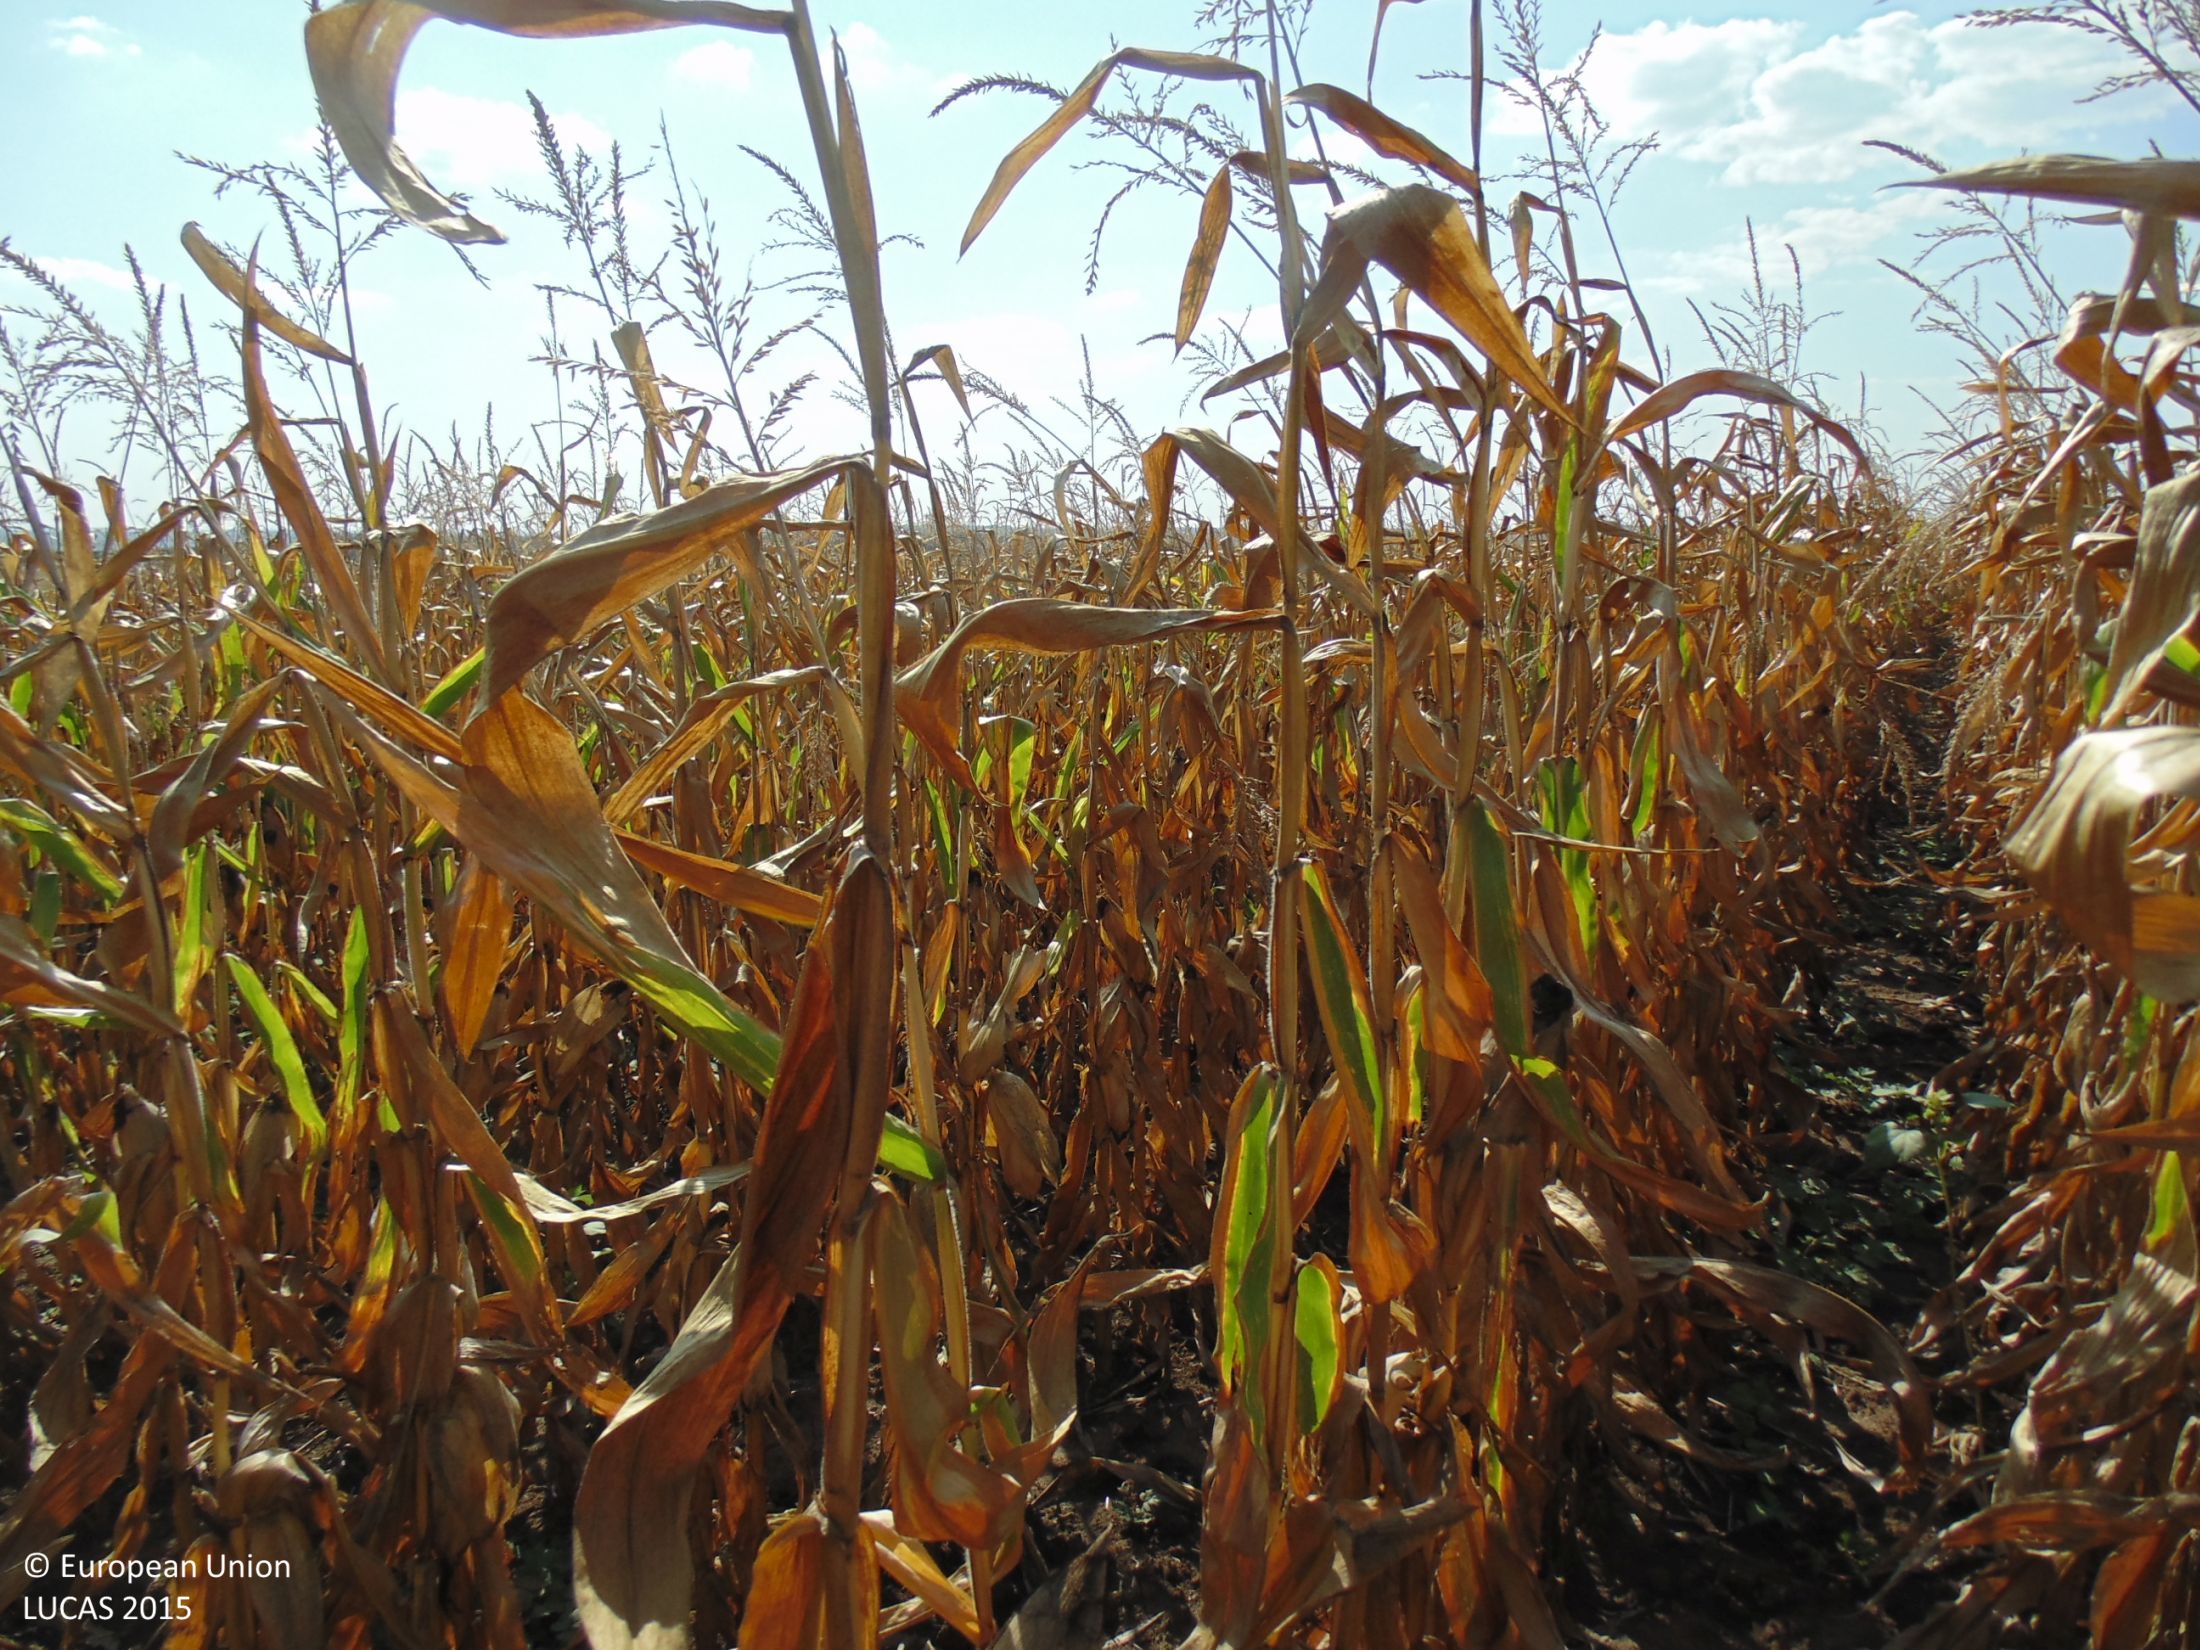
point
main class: Cropland
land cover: Maize
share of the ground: > 75 %
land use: Agriculture (excluding fallow land and kitchen gardens)
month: August
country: BG
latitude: 43.7046
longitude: 27.2389
